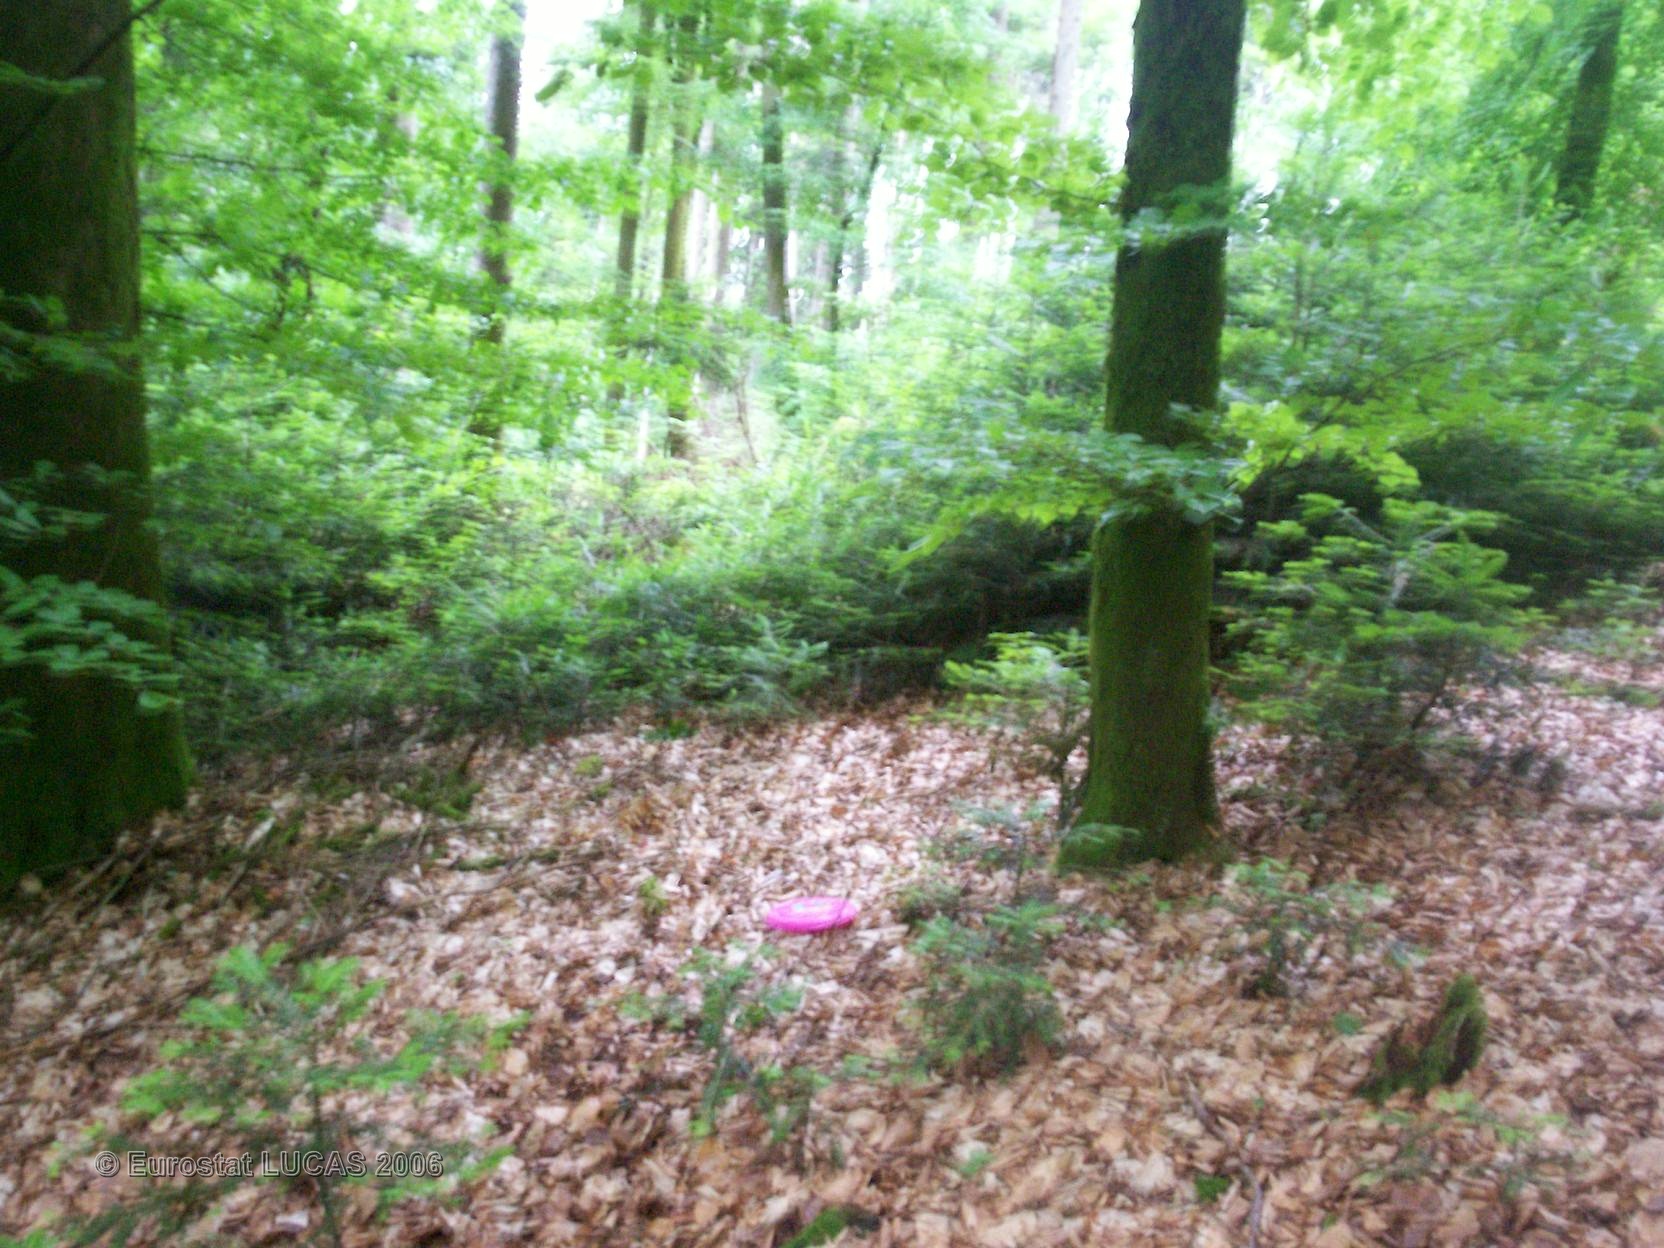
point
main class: Woodland
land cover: Mixed forest
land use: Forestry
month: May
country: FR
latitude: 48.1515
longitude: 6.5463
